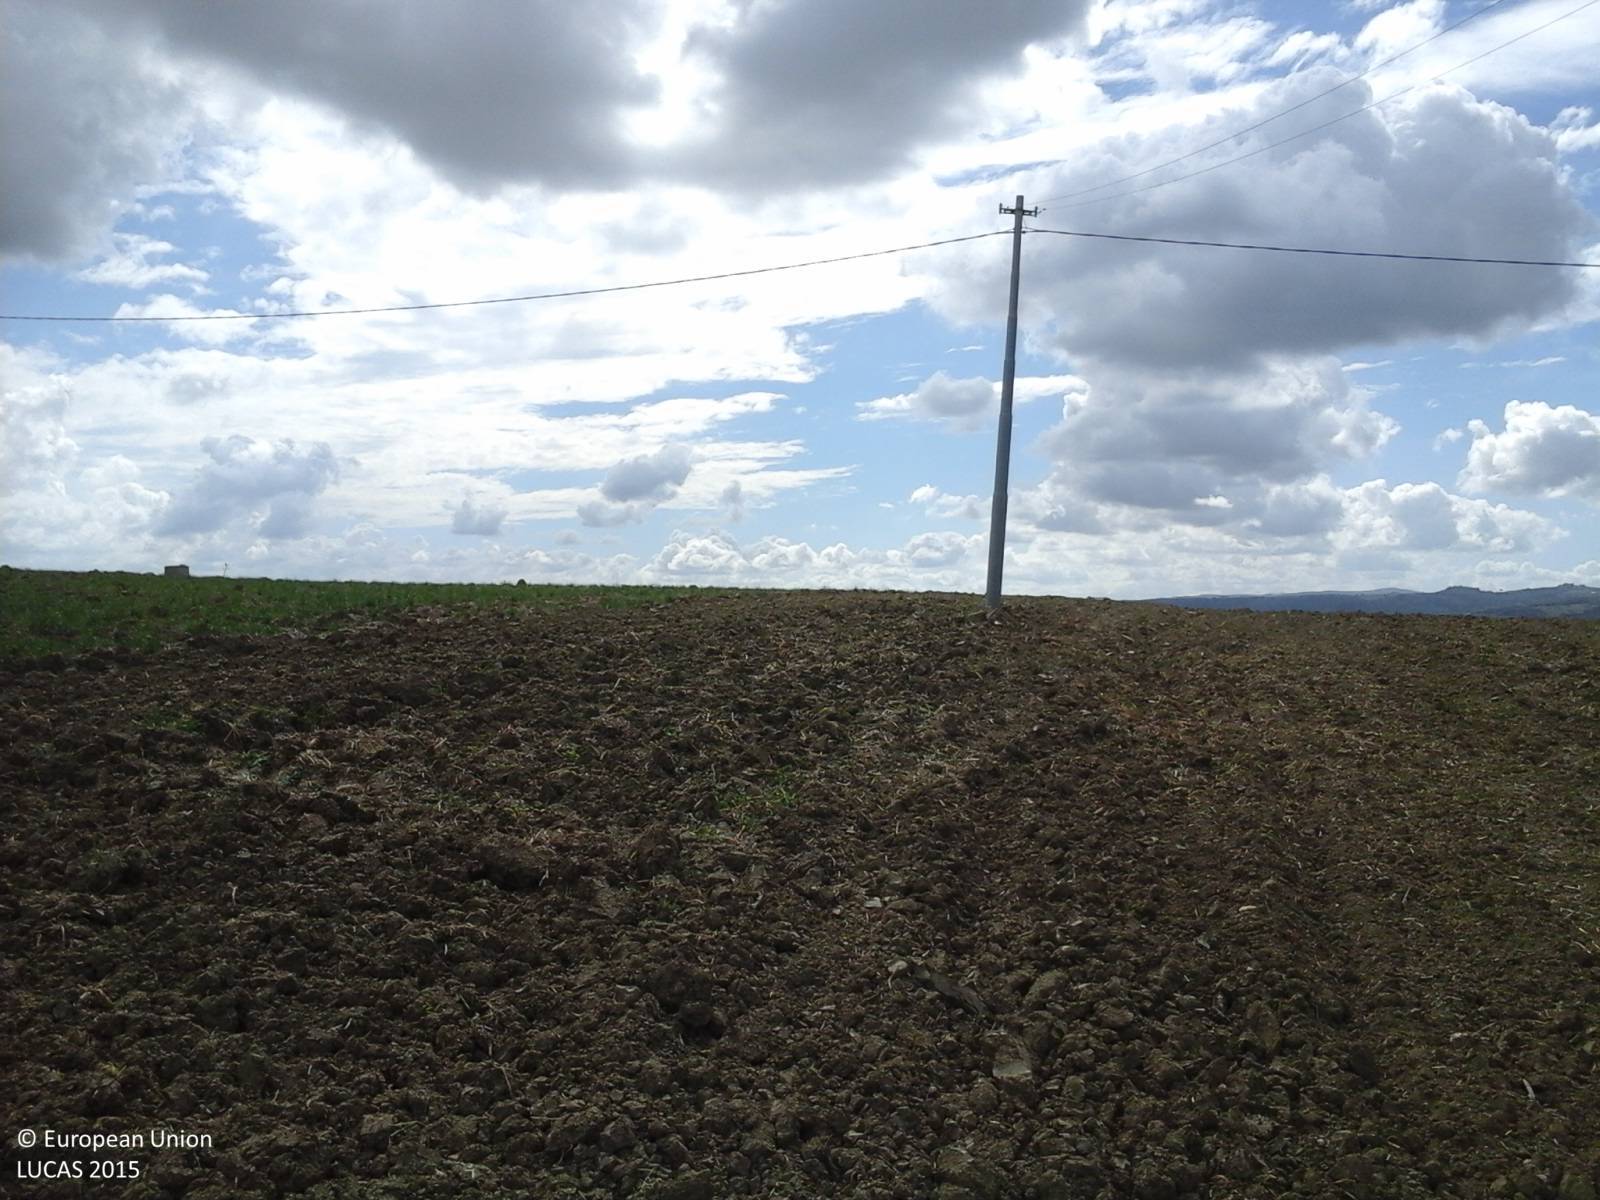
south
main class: Cropland
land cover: Barley
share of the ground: < 10 %
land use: Agriculture (excluding fallow land and kitchen gardens)
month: September
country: IT
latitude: 42.9343
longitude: 12.3334
